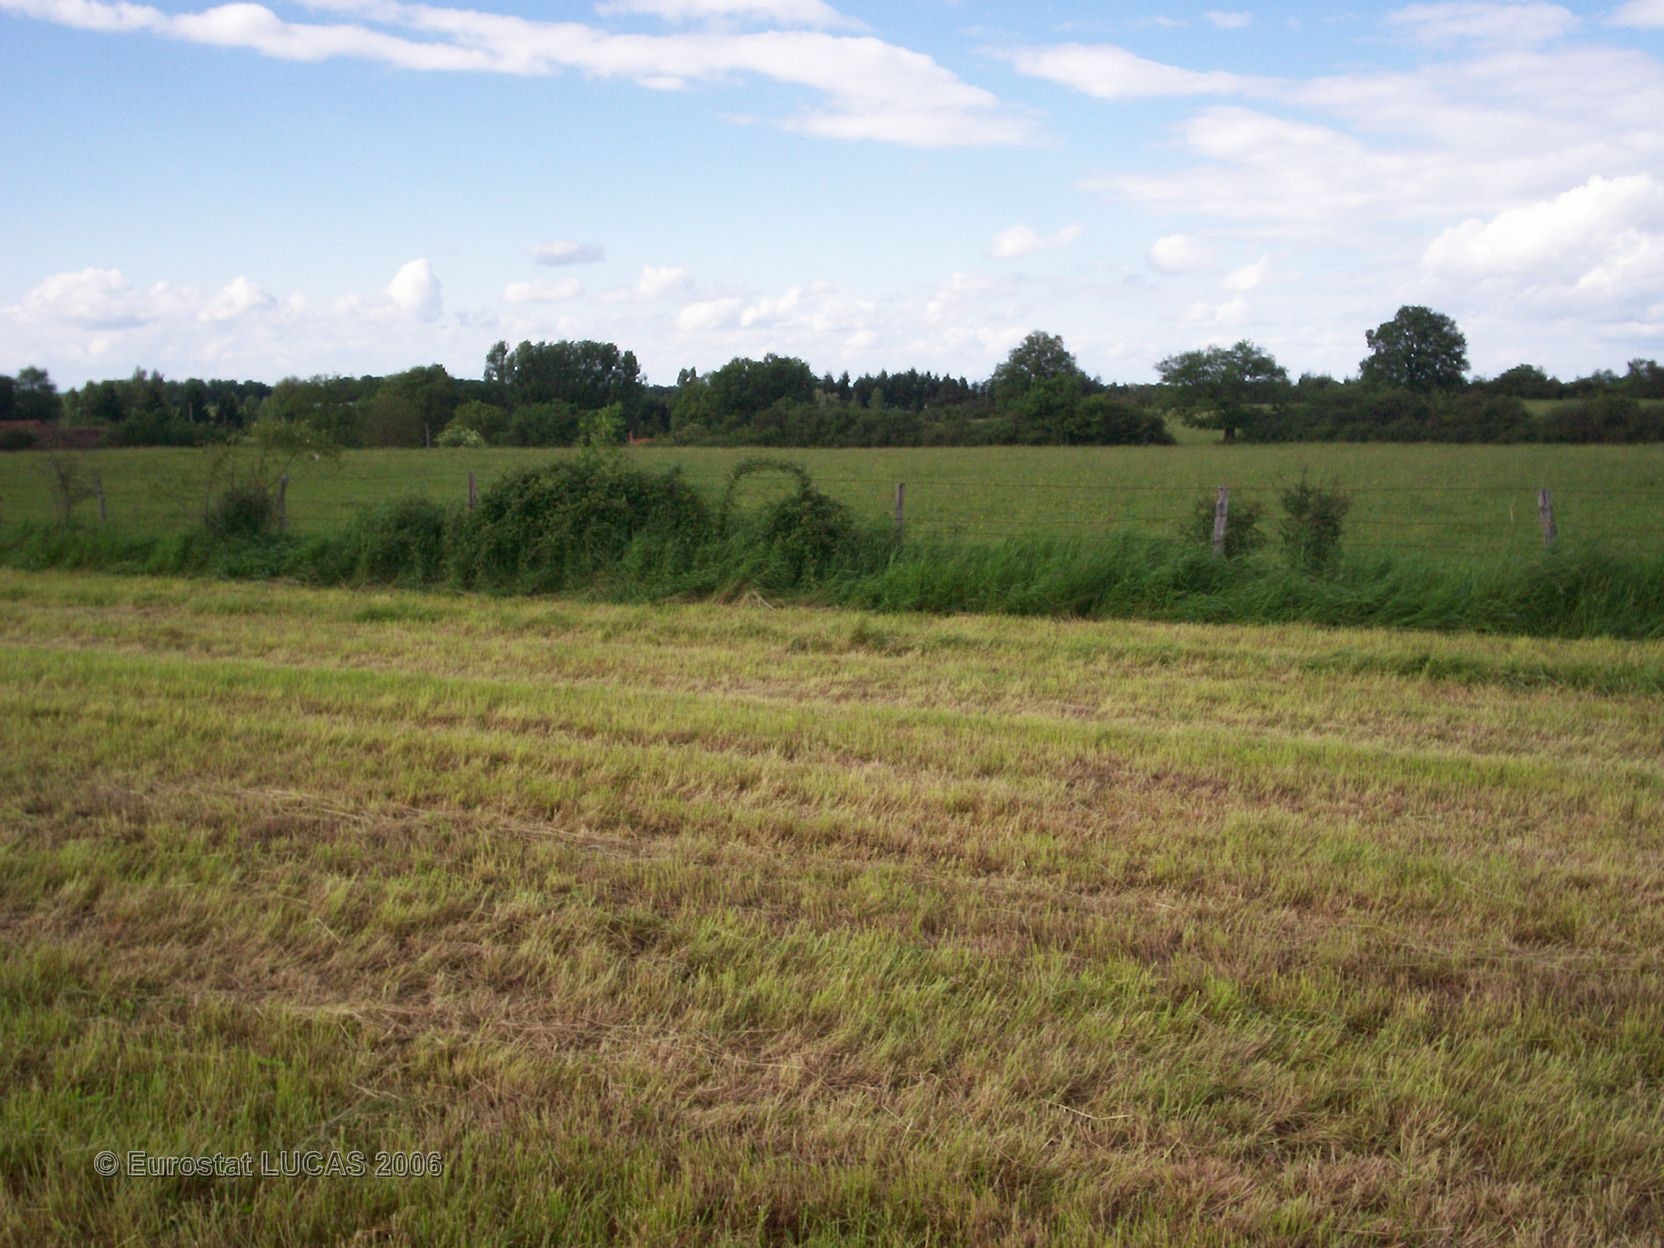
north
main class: Grassland
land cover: Grassland without tree/shrub cover
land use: Agriculture (excluding fallow land and kitchen gardens)
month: May
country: FR
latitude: 46.8289
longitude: 3.0352
